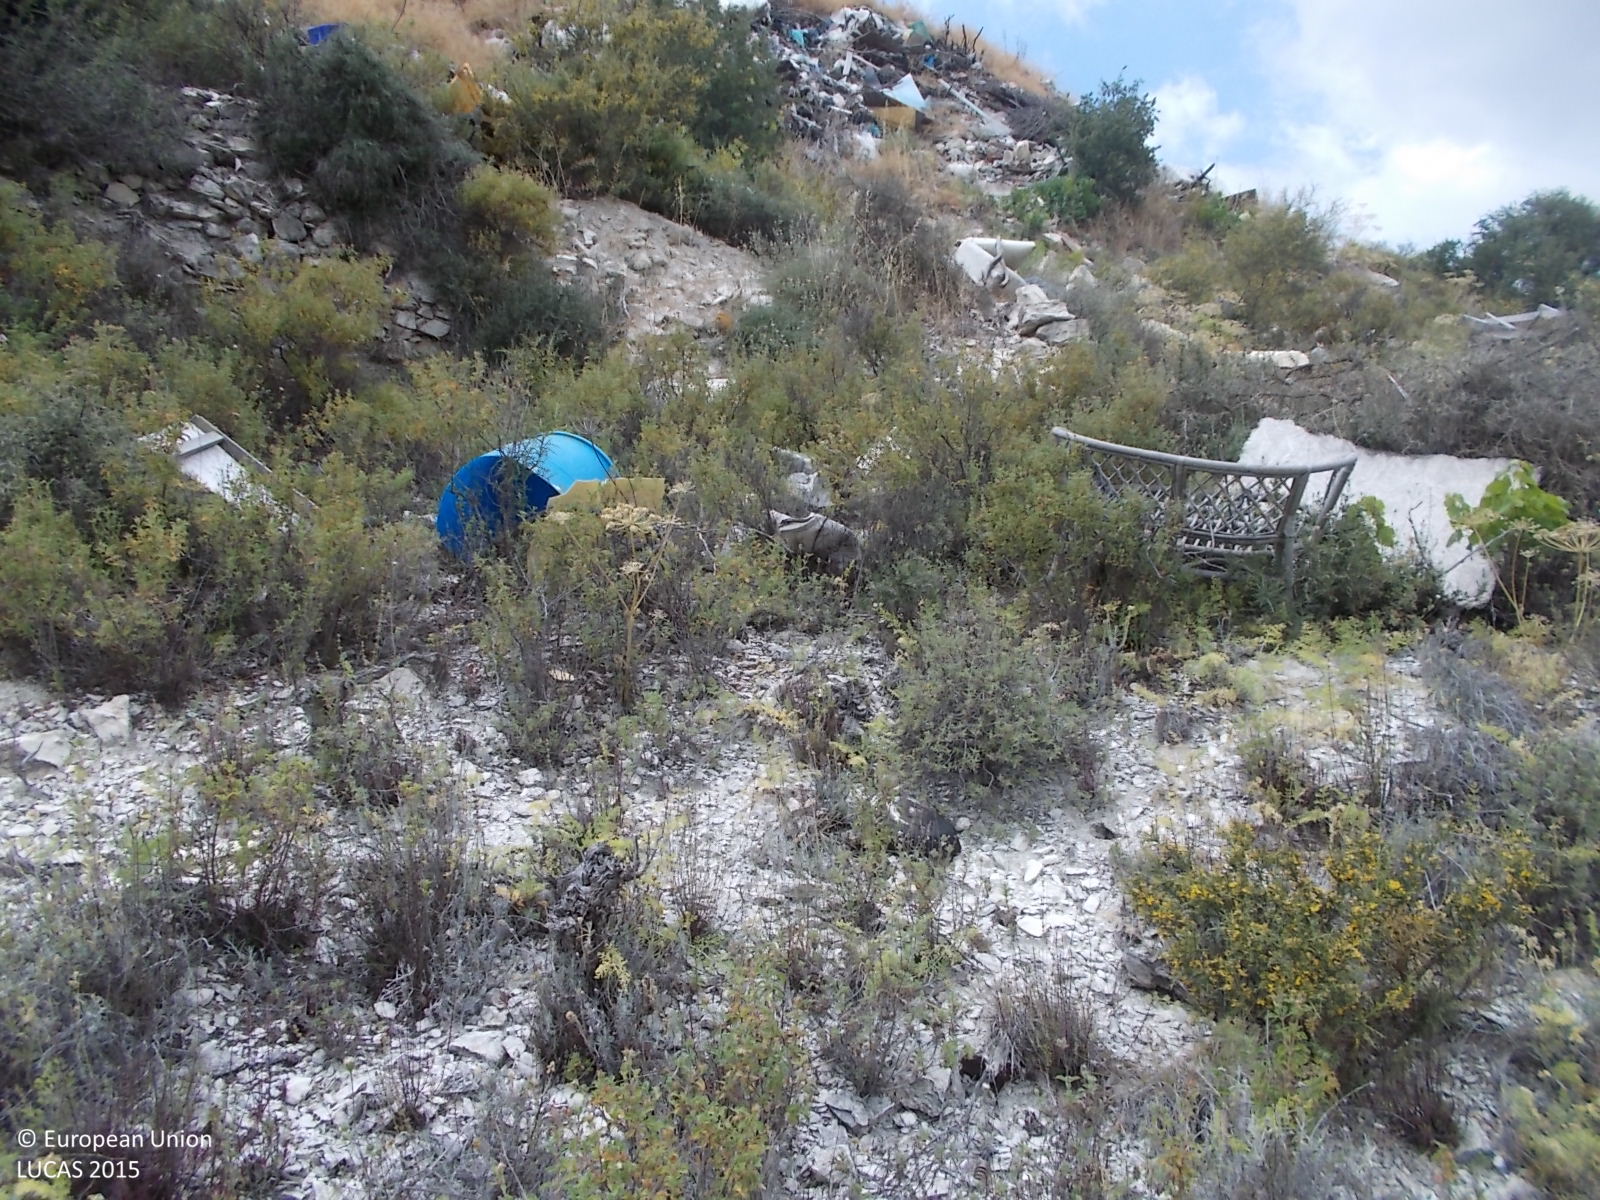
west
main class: Shrubland
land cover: Shrubland without tree cover
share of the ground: 50 - 75 %
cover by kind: shrubs 75 %, consolidated bare surface 15 %, unconsolidated bare surface 10 %
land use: Semi-natural and natural areas not in use
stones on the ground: 25 - 50 %
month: June
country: CY
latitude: 34.8598
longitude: 32.8149
